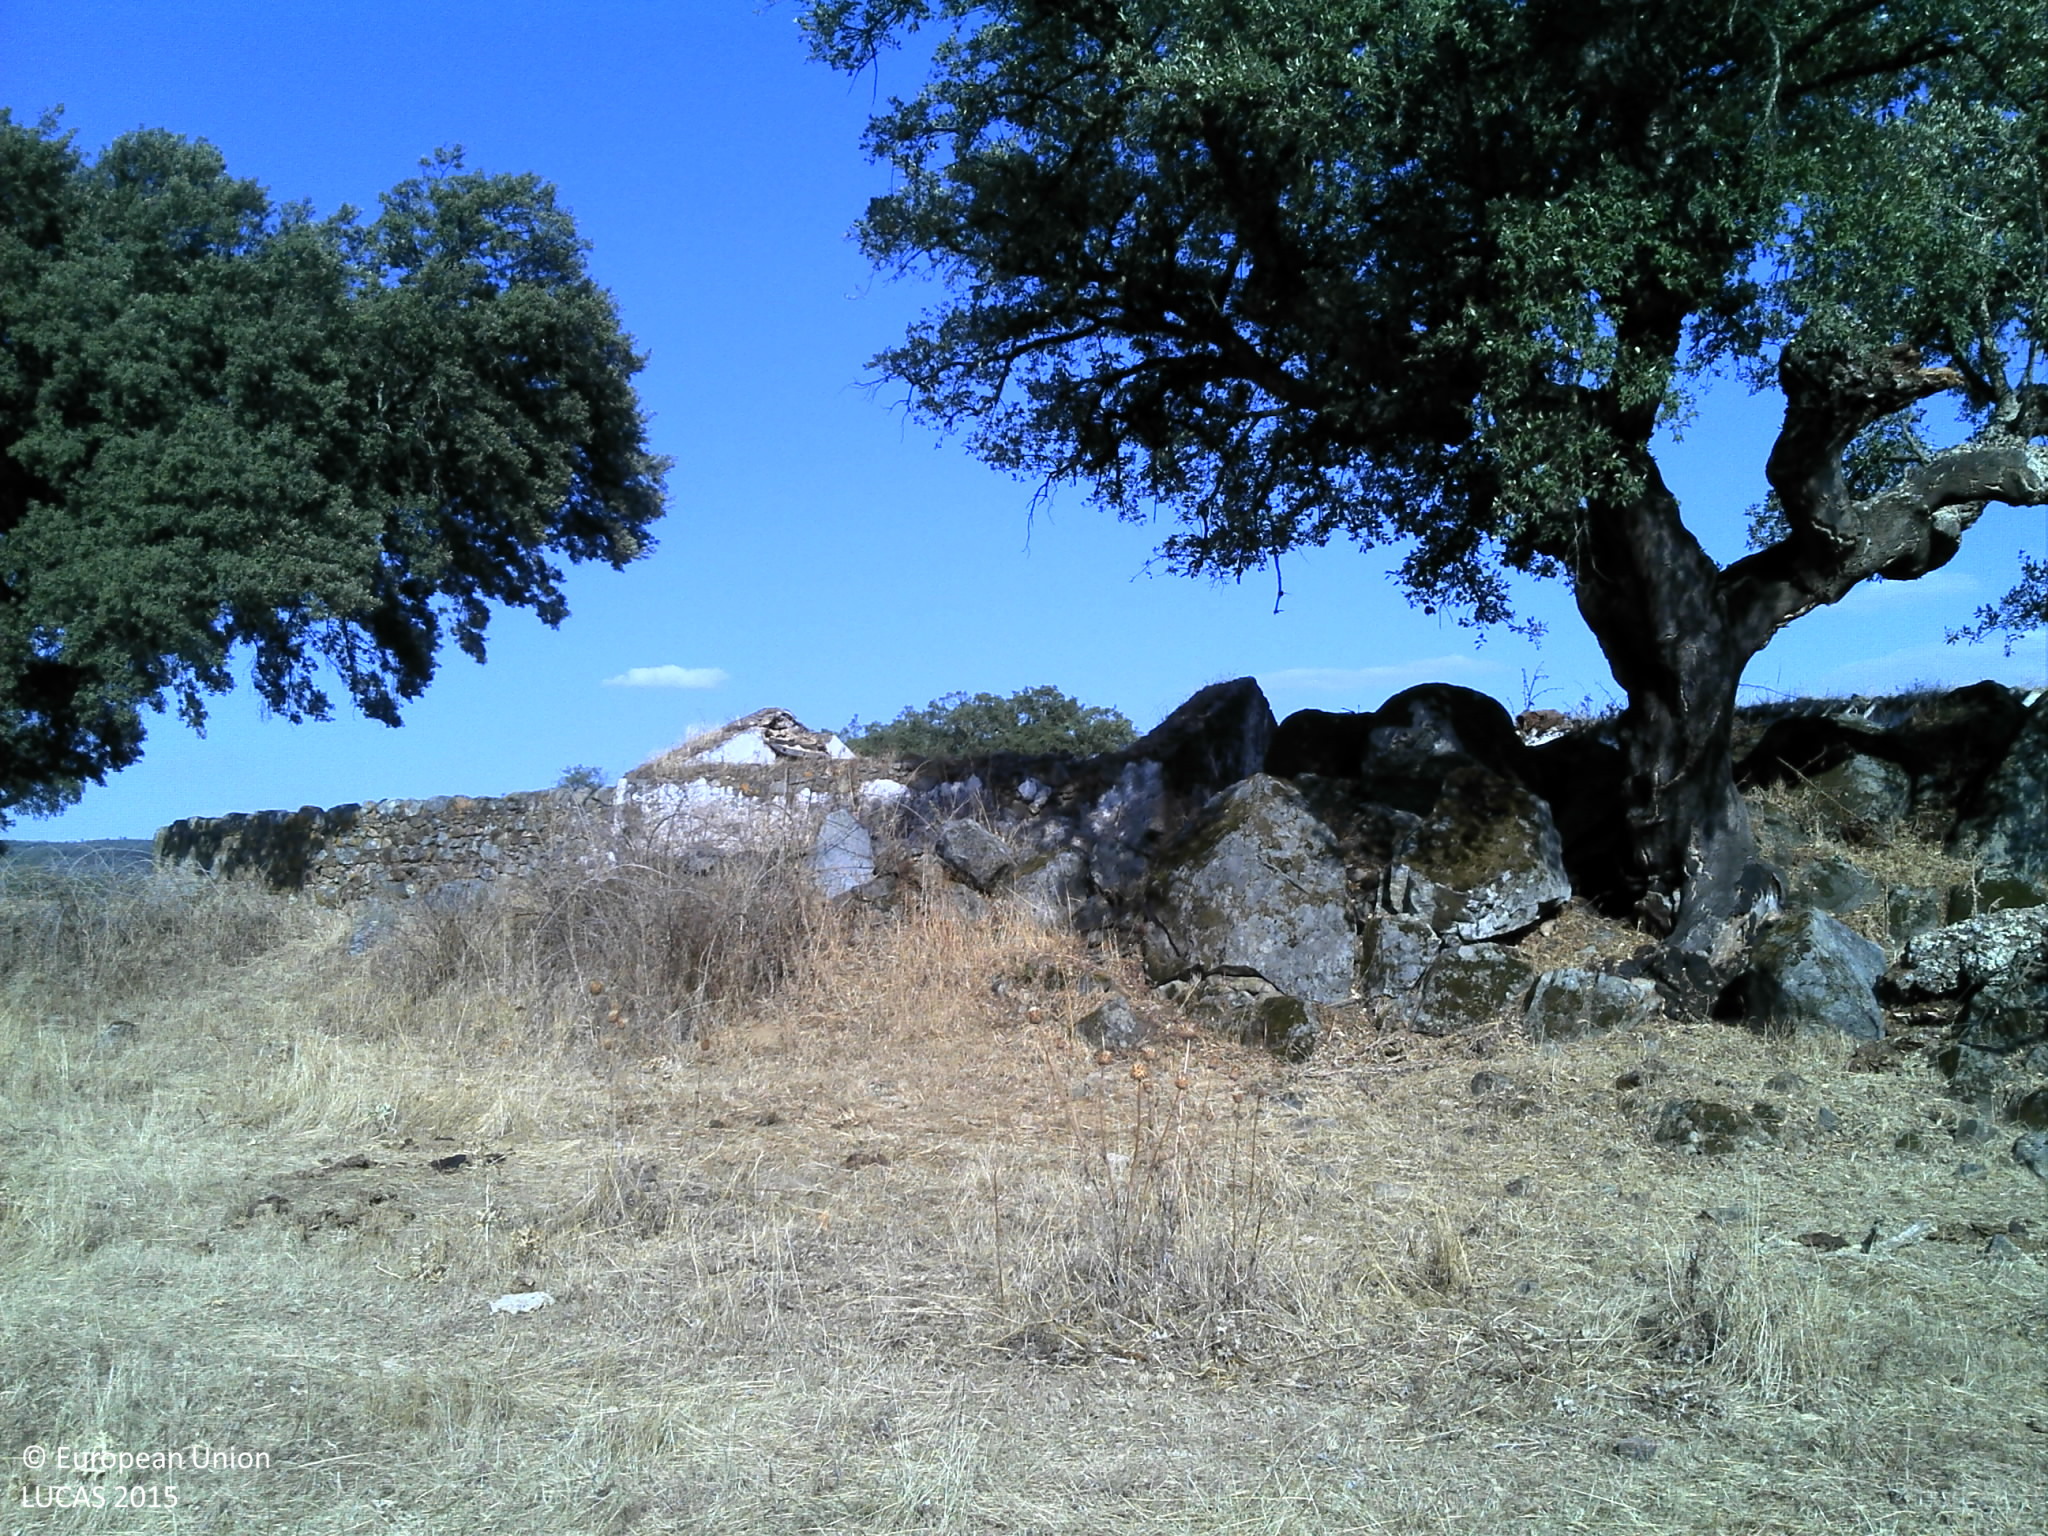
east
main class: Woodland
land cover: Broadleaved woodland
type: broadleaved evergreen forest
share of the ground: 10 - 25 %
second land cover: Grassland without tree/shrub cover
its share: 10 - 25 %
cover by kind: unconsolidated bare surface 70 %, broadleaved forest trees 15 %, herbaceous plants 15 %
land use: Forestry
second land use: Agriculture (excluding fallow land and kitchen gardens)
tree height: > 5 m
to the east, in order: Broadleaved woodland; Grassland without tree/shrub cover; Rock outcrops; Artificial constructions in urban areas; Grassland without tree/shrub cover; Broadleaved woodland; Grassland without tree/shrub cover; Broadleaved woodland; Grassland with sparse tree/shrub cover; Broadleaved woodland
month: August
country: PT
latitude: 39.3088
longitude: -7.4972
